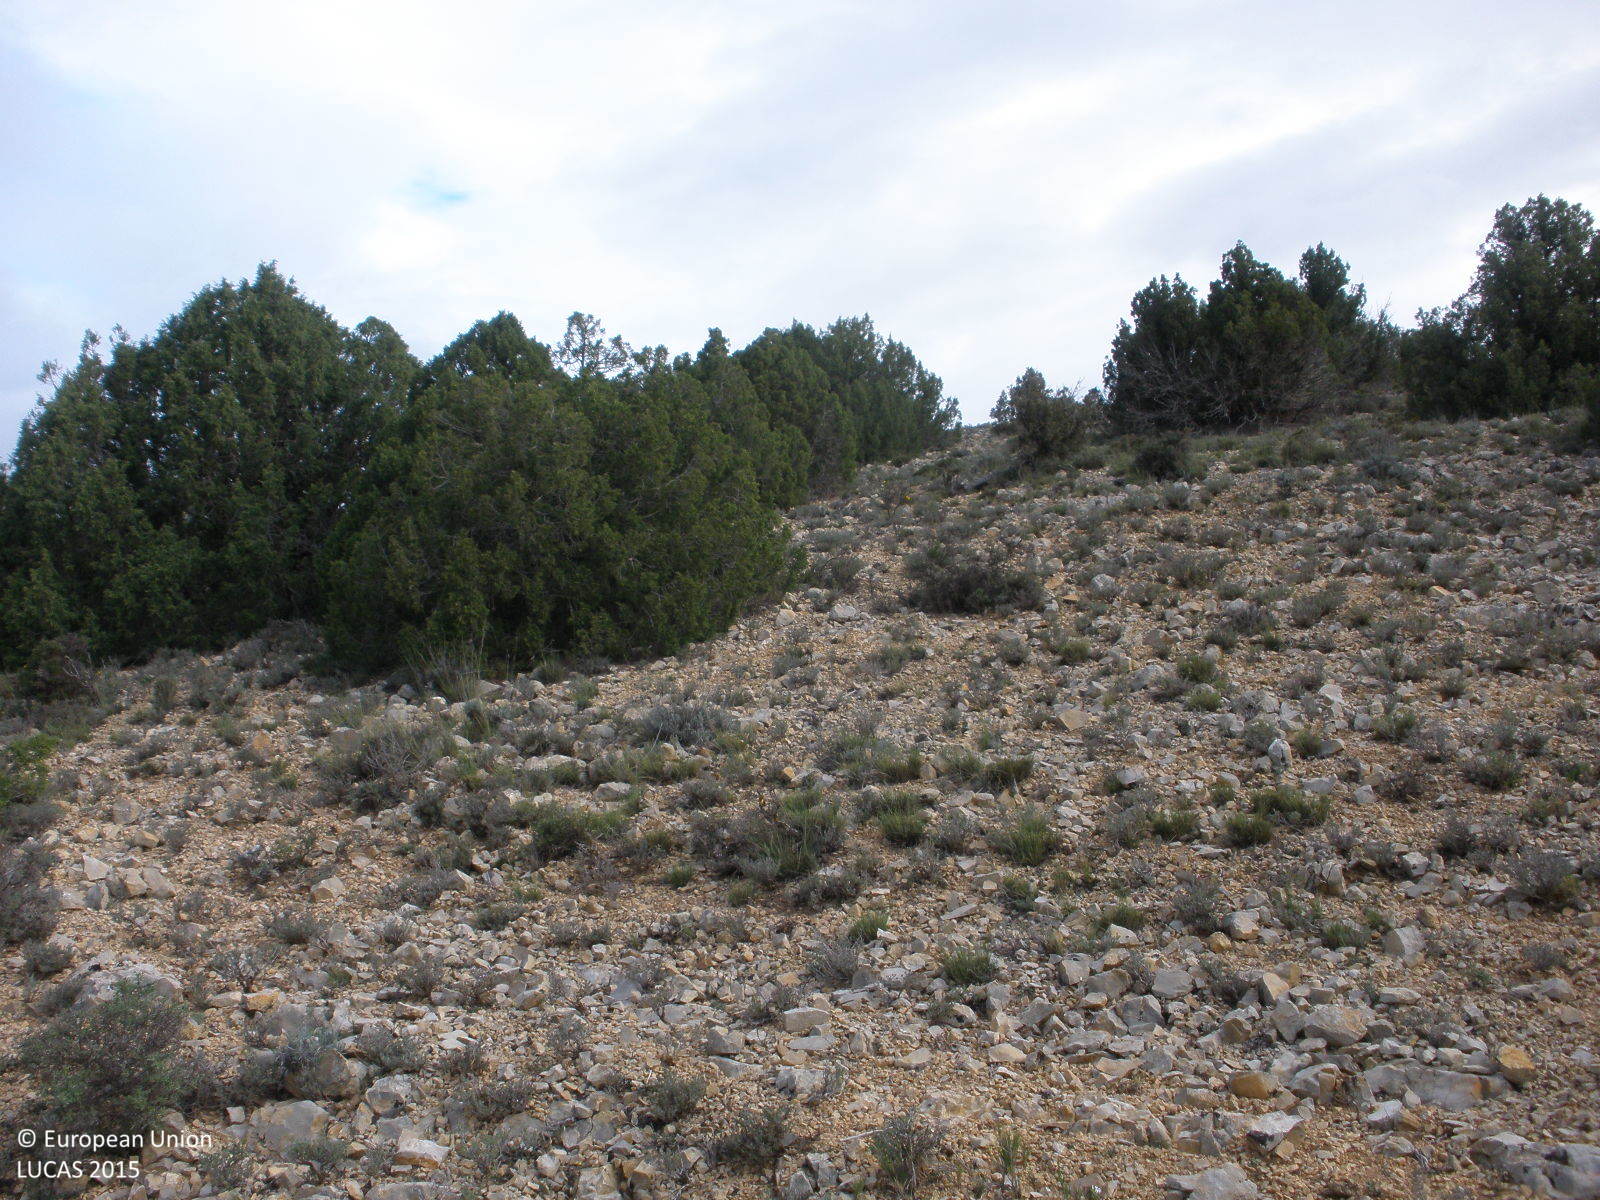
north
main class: Woodland
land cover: Other coniferous woodland
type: coniferous forest of the mediterranean region
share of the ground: > 75 %
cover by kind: coniferous forest trees 40 %, shrubs 30 %, consolidated bare surface 30 %
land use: Semi-natural and natural areas not in use
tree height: < 5 m
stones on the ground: > 50 %
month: April
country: ES
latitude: 40.3475
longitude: -1.2551
